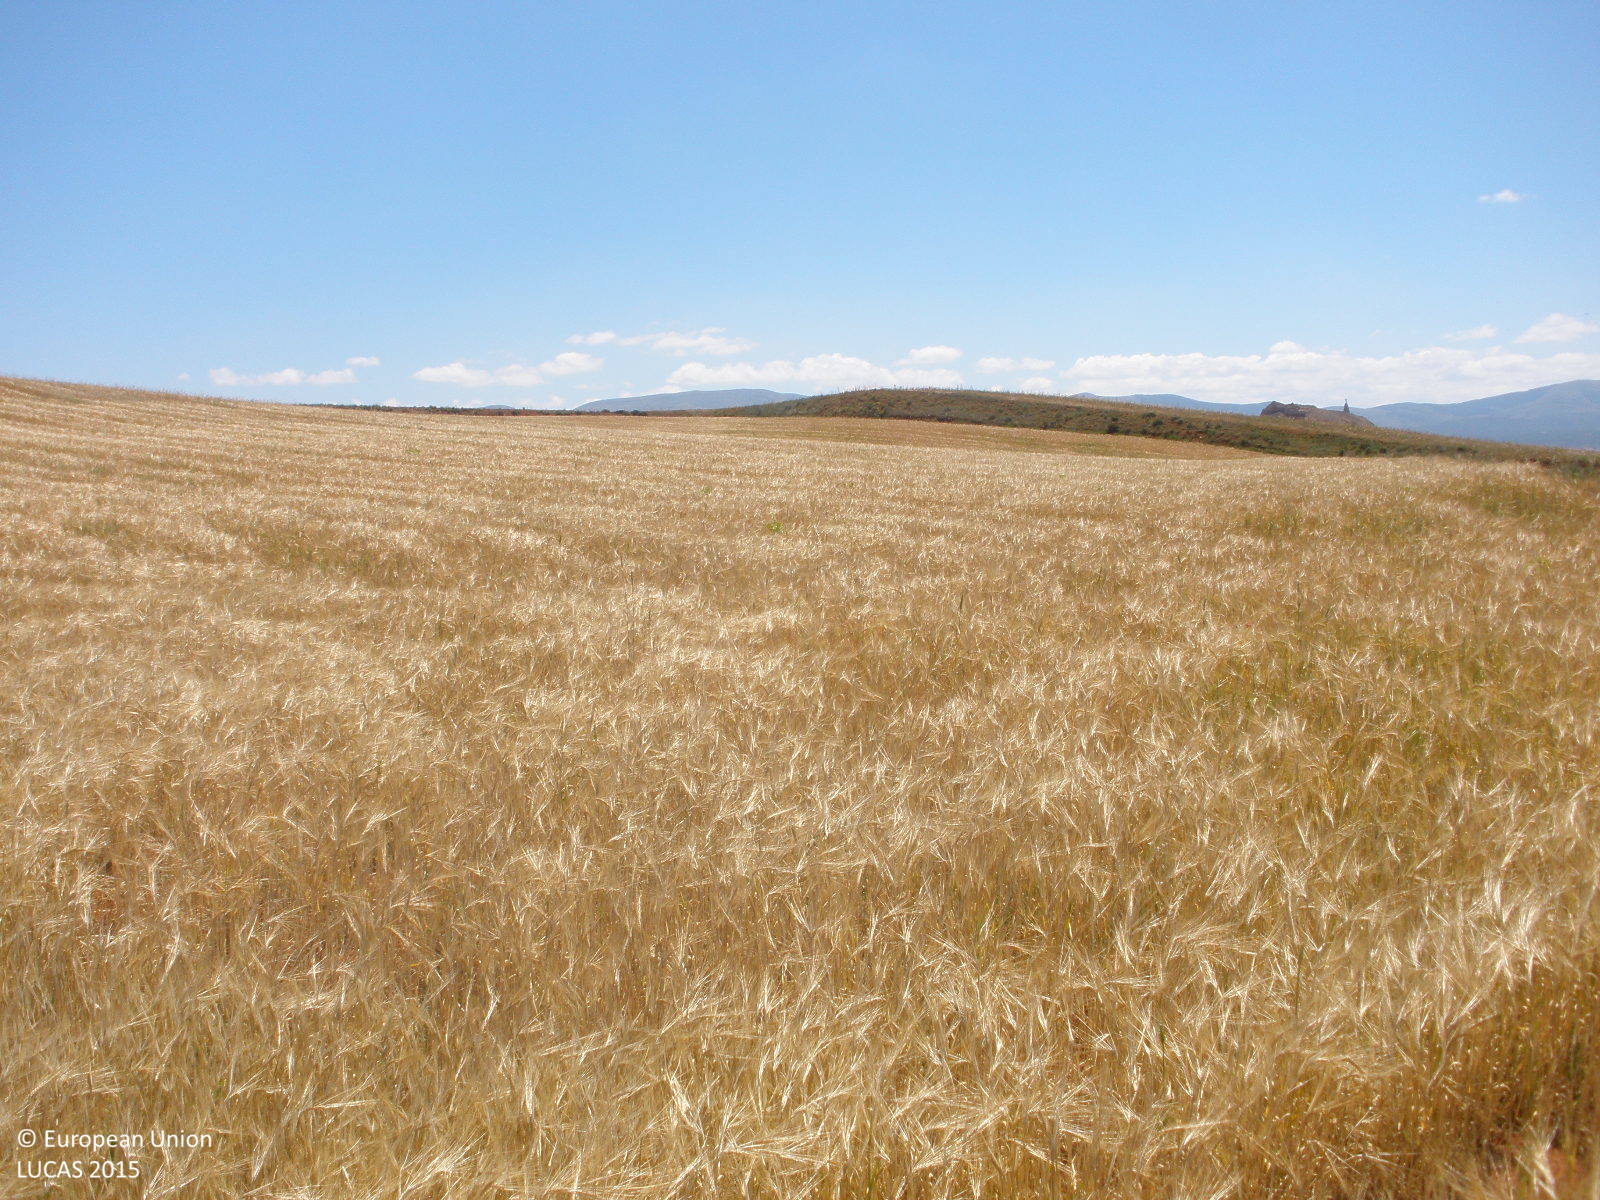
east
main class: Cropland
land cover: Barley
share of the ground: > 75 %
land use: Agriculture (excluding fallow land and kitchen gardens)
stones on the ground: < 10 %
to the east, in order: Barley; Grass margins; Other bare soil
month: June
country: ES
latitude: 40.5528
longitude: -1.0539
